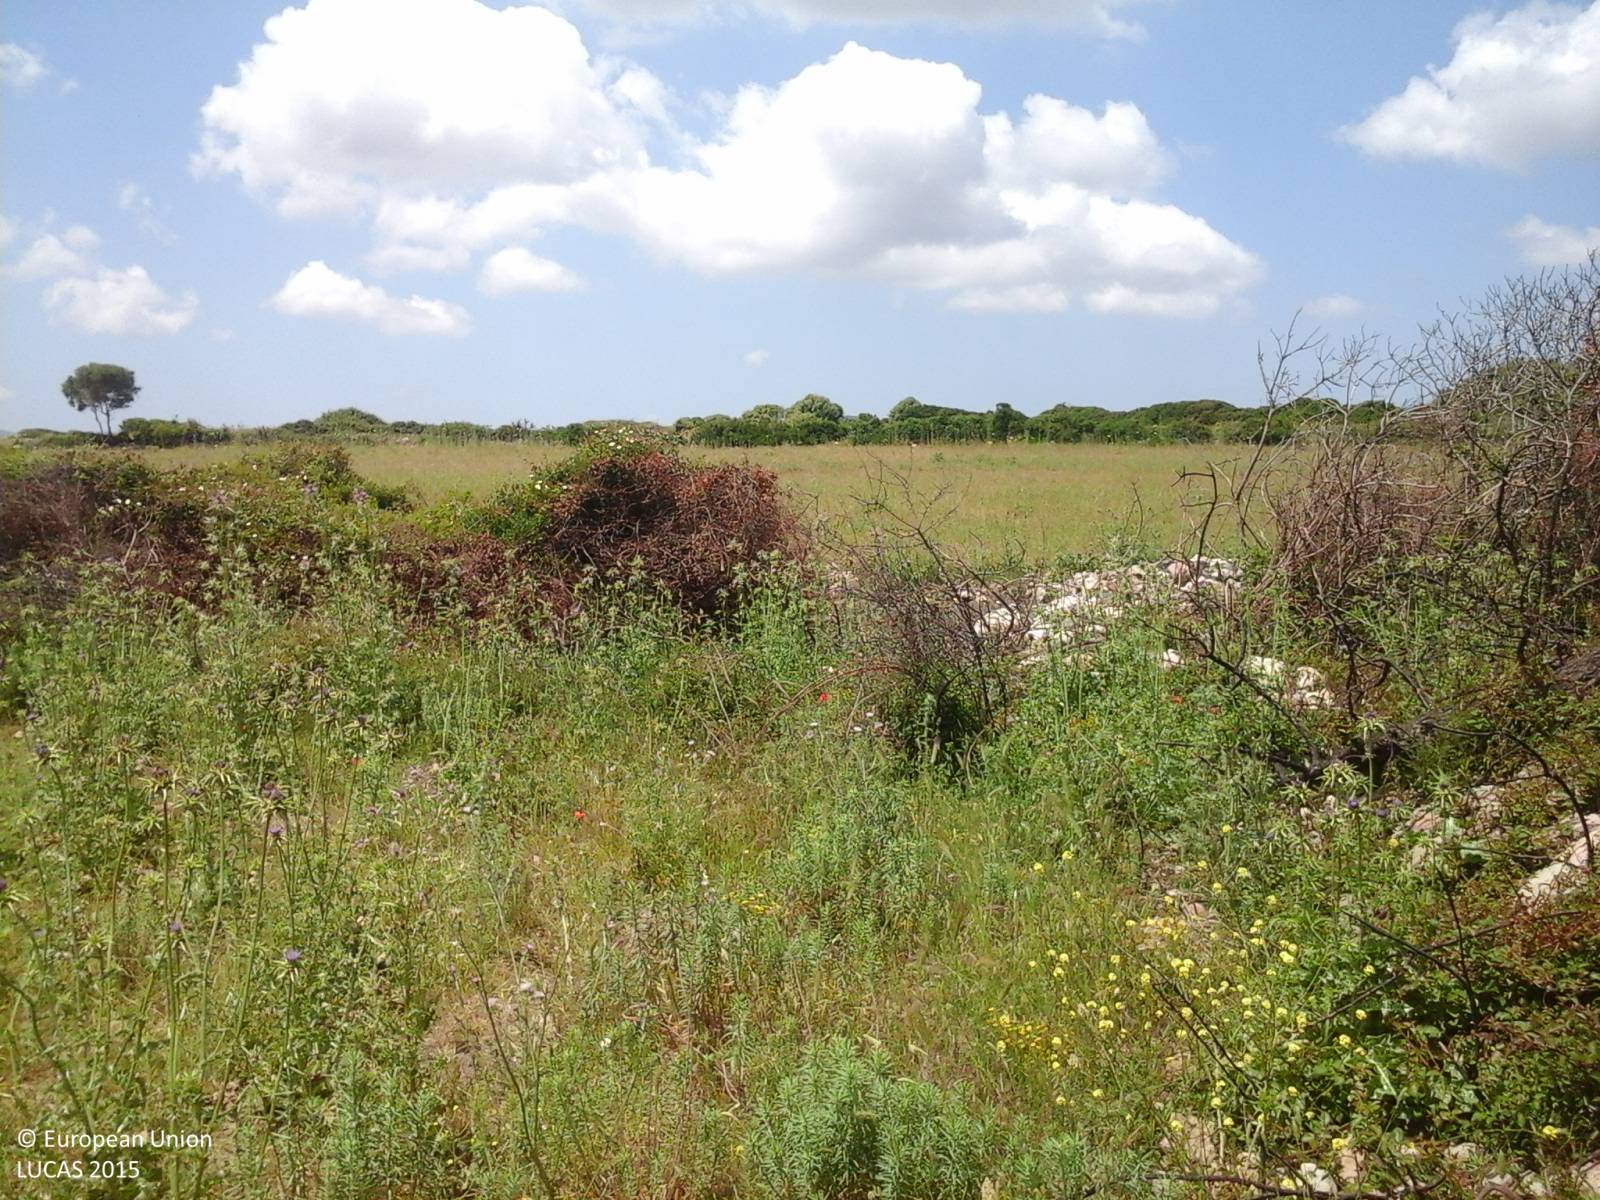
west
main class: Grassland
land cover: Spontaneously vegetated surfaces
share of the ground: > 75 %
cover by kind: herbaceous plants 50 %, shrubs 5 %, unconsolidated bare surface 5 %
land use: Agriculture (excluding fallow land and kitchen gardens)
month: May
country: IT
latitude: 40.7428
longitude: 8.3853
